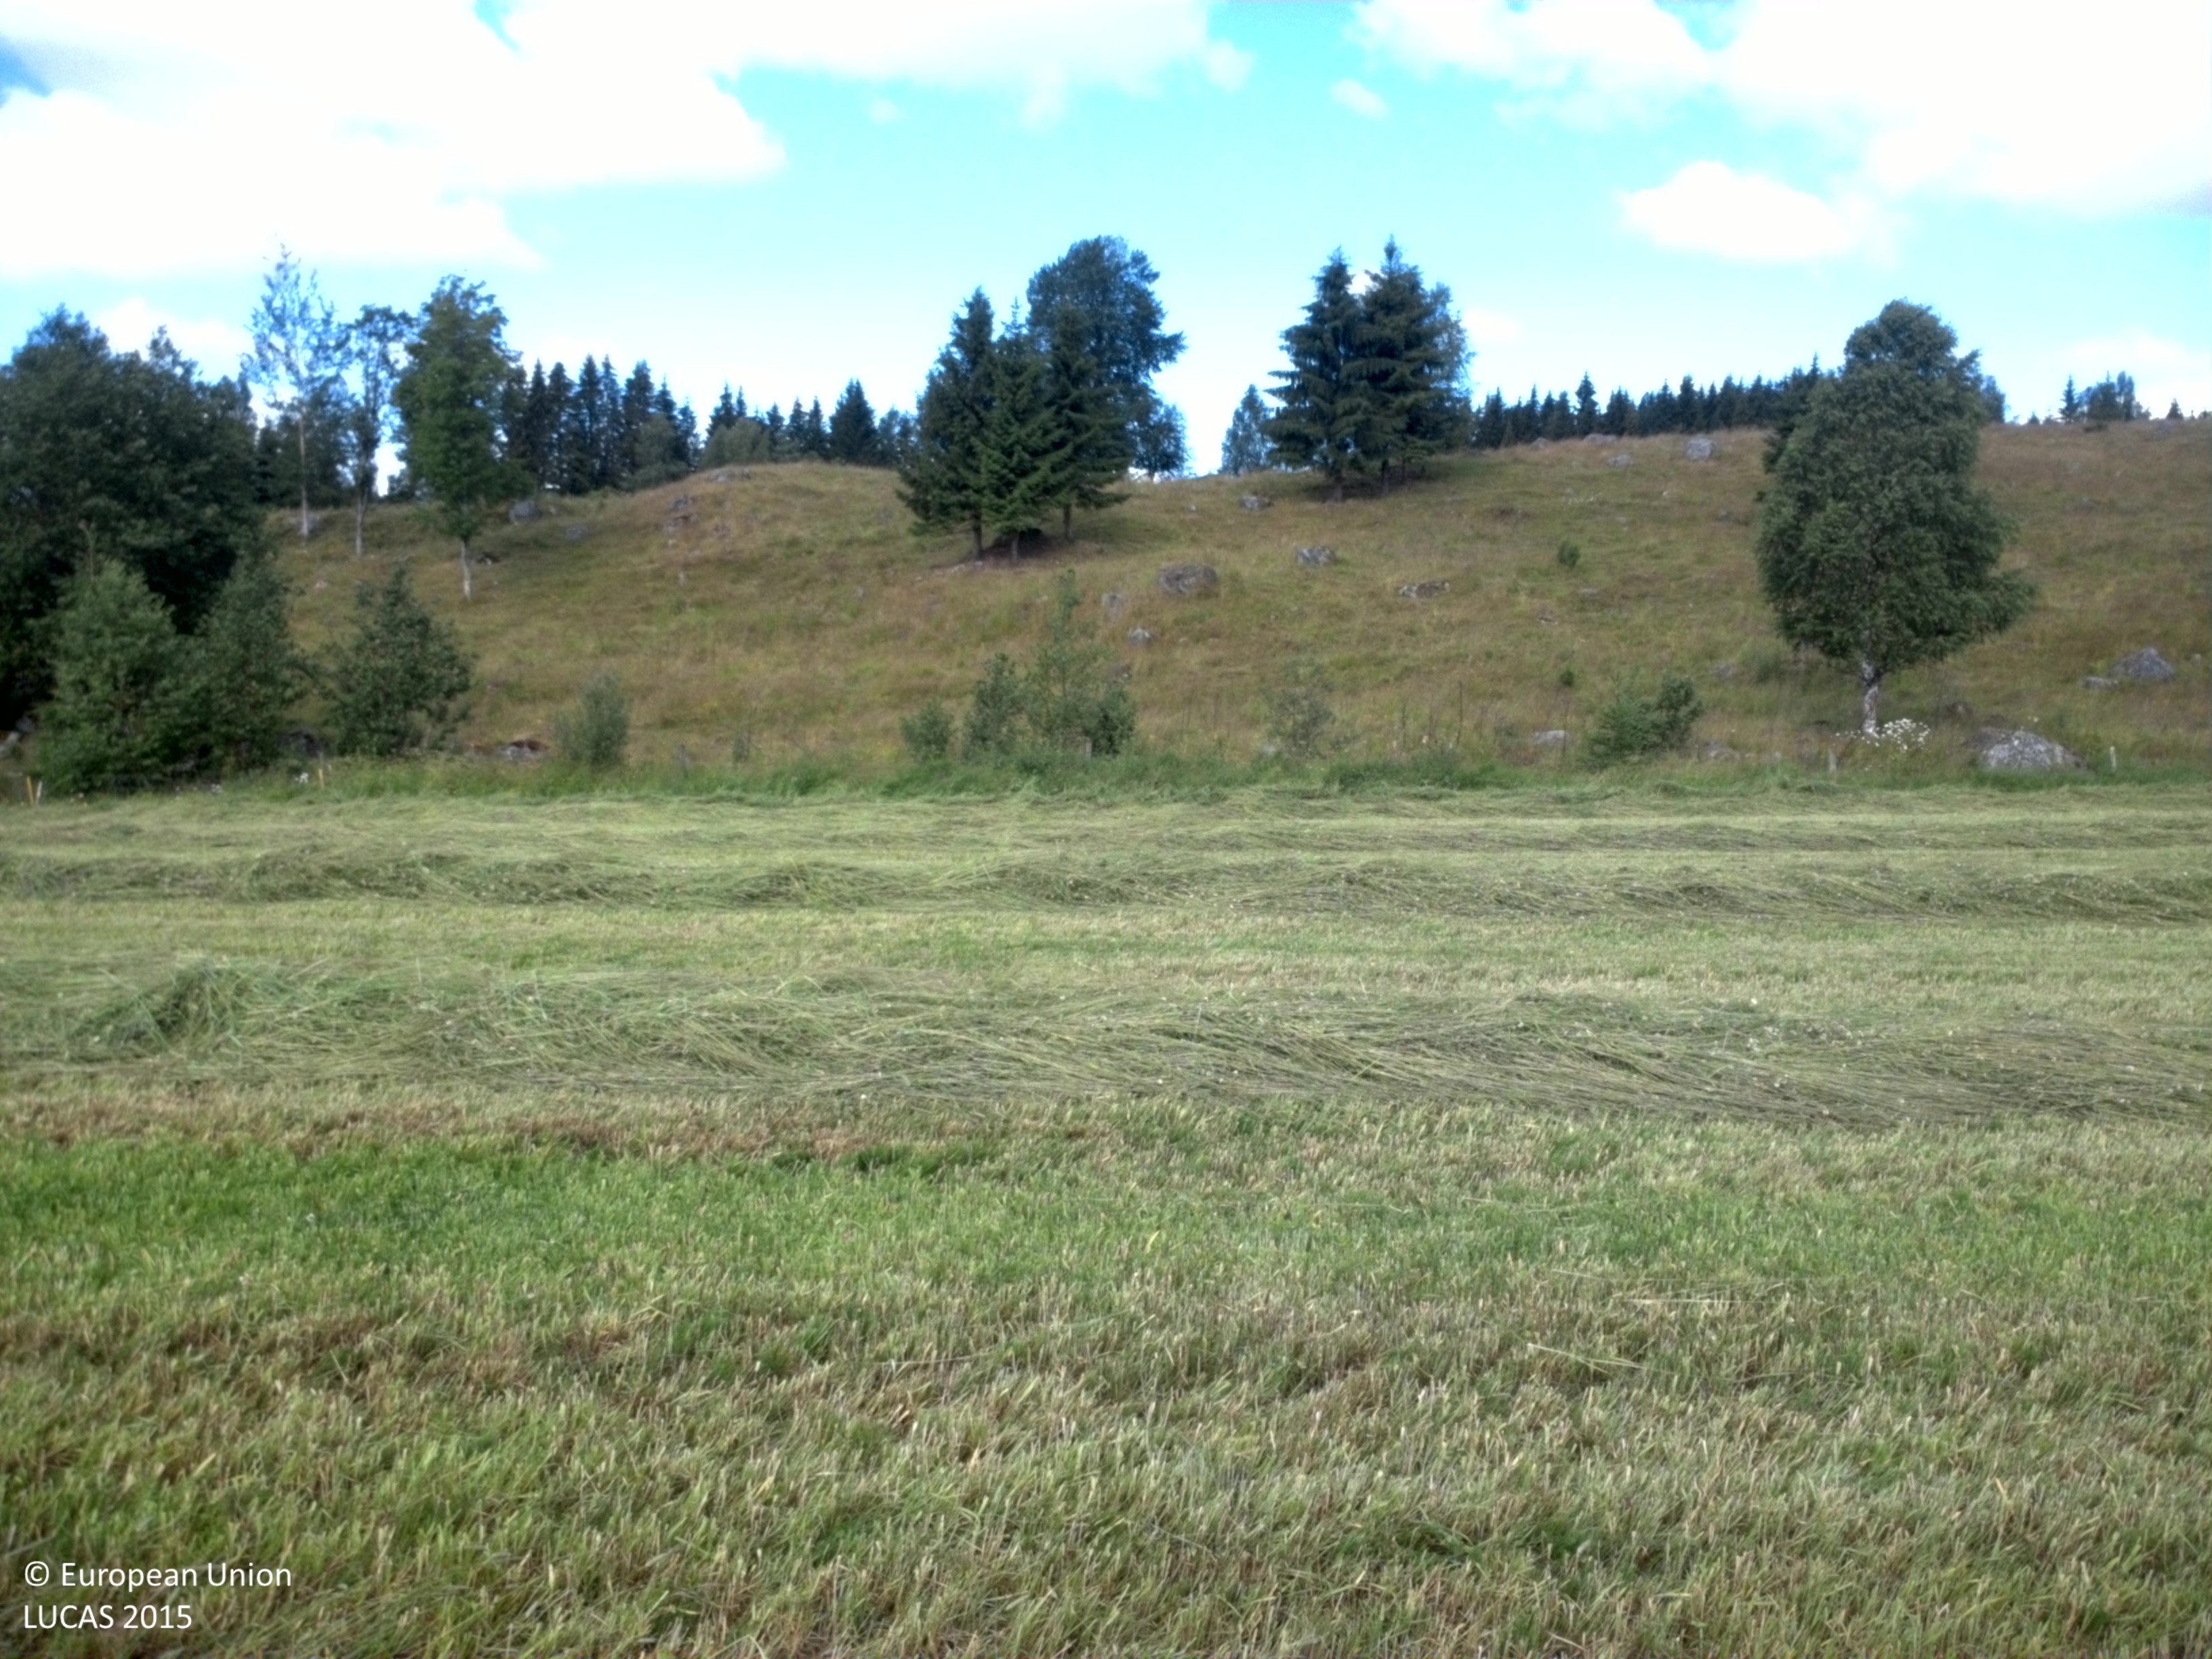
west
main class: Cropland
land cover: Other leguminous and mixtures for fodder
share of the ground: > 75 %
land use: Agriculture (excluding fallow land and kitchen gardens)
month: July
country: SE
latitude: 59.8534
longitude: 12.4389
